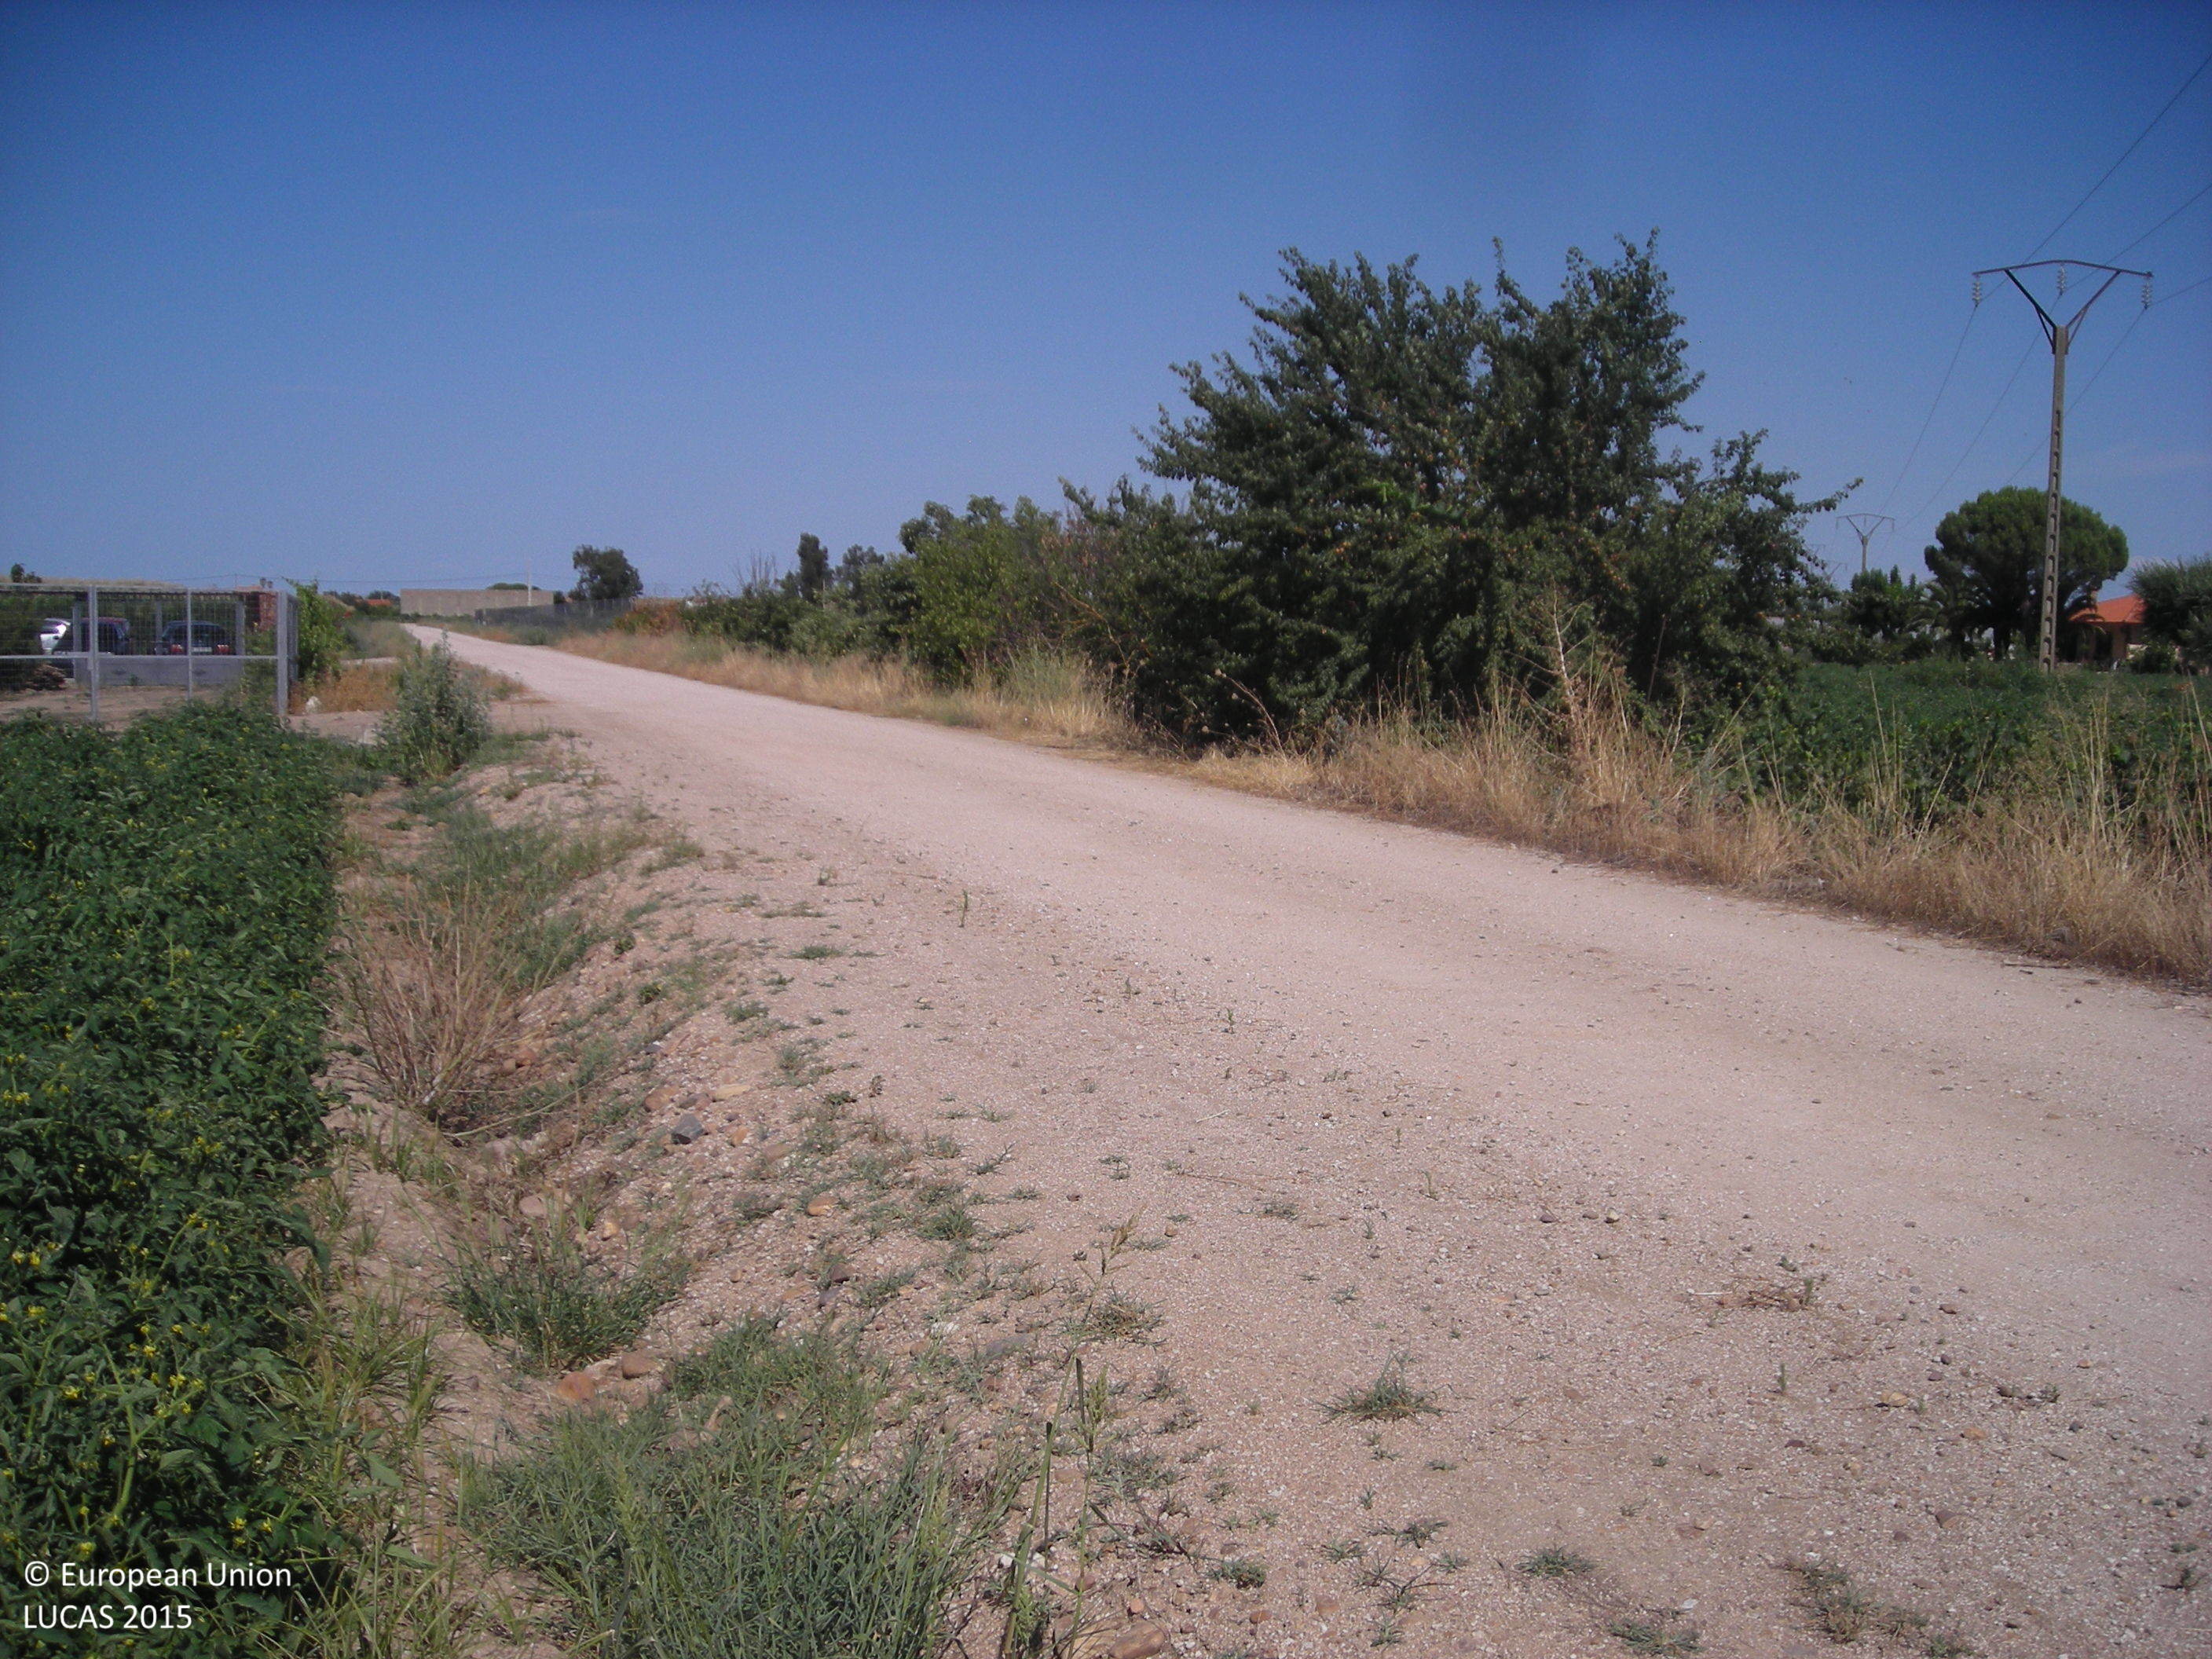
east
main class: Cropland
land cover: Tomatoes
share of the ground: > 75 %
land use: Agriculture (excluding fallow land and kitchen gardens)
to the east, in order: Tomatoes; Fences; Vineyards; Fences; Maize
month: July
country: ES
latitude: 38.9546
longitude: -5.9404
